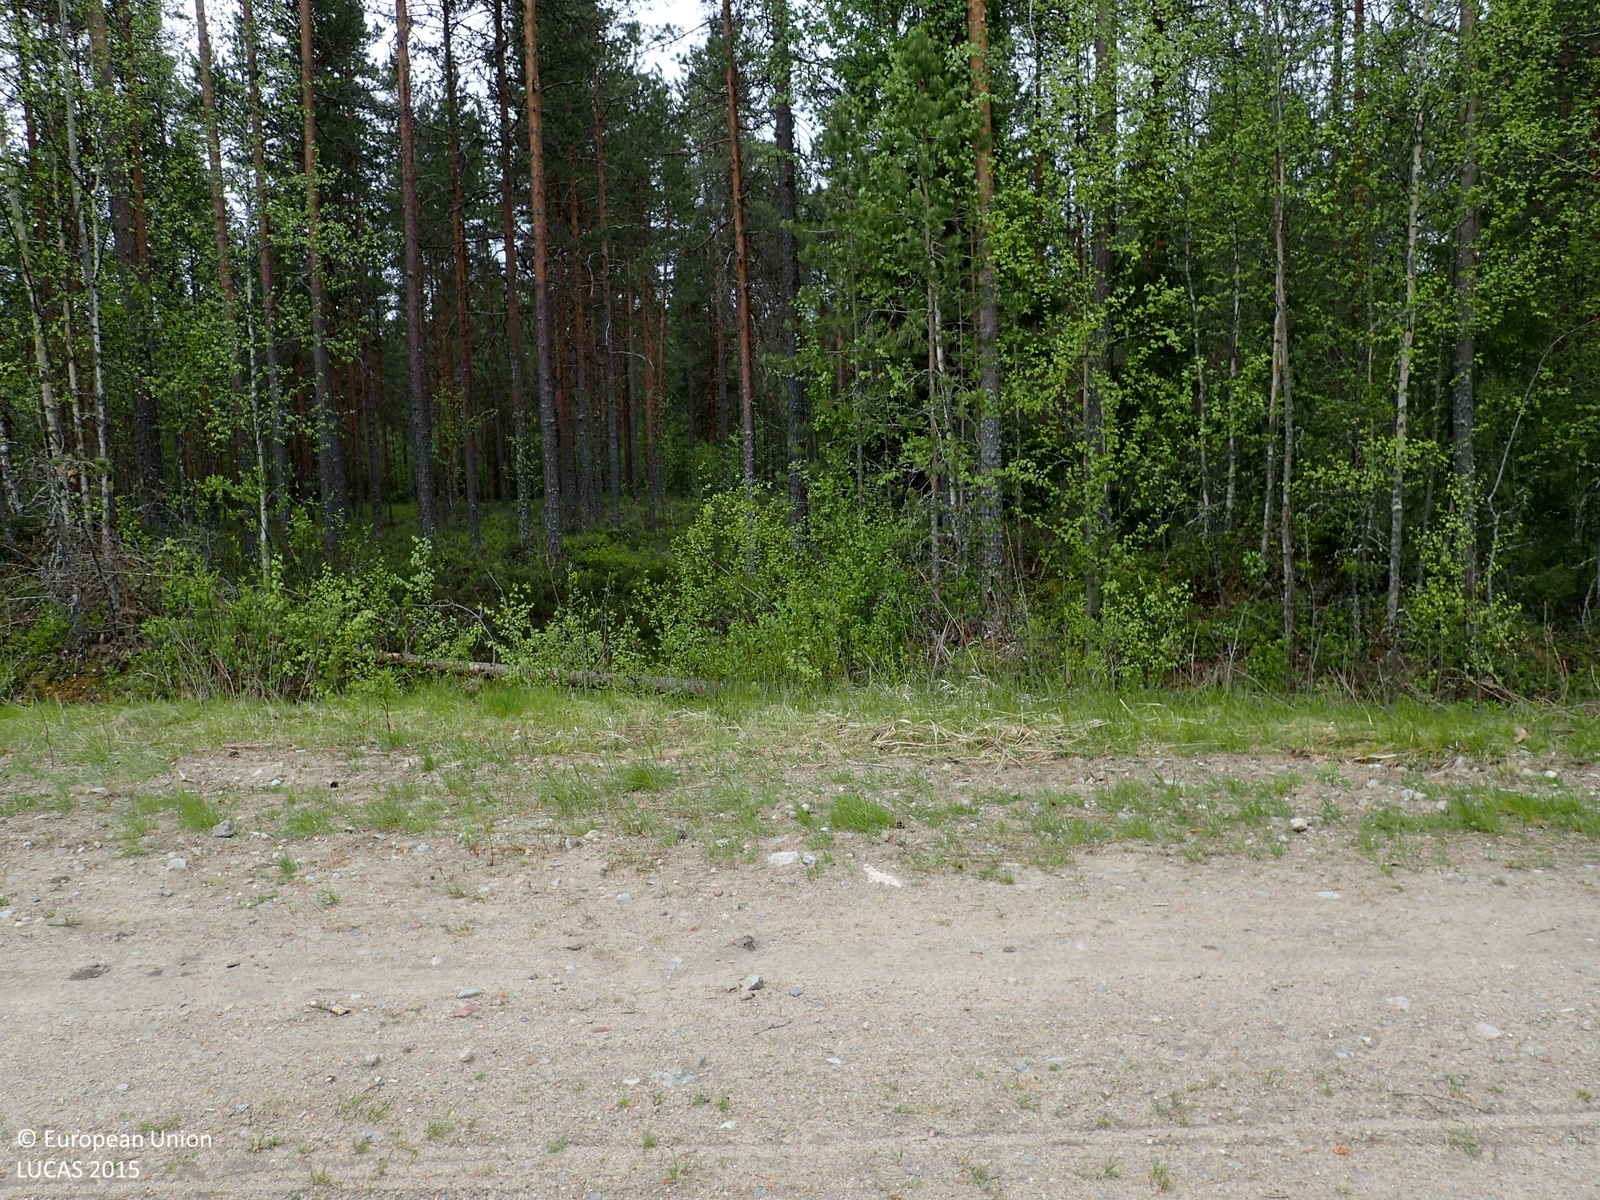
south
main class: Woodland
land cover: Pine dominated coniferous woodland
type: boreal forest
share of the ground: 25 - 50 %
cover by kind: herbaceous plants 40 %, shrubs 35 %, coniferous forest trees 20 %, broadleaved forest trees 5 %
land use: Forestry
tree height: > 5 m
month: June
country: FI
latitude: 62.2789
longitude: 21.7447
